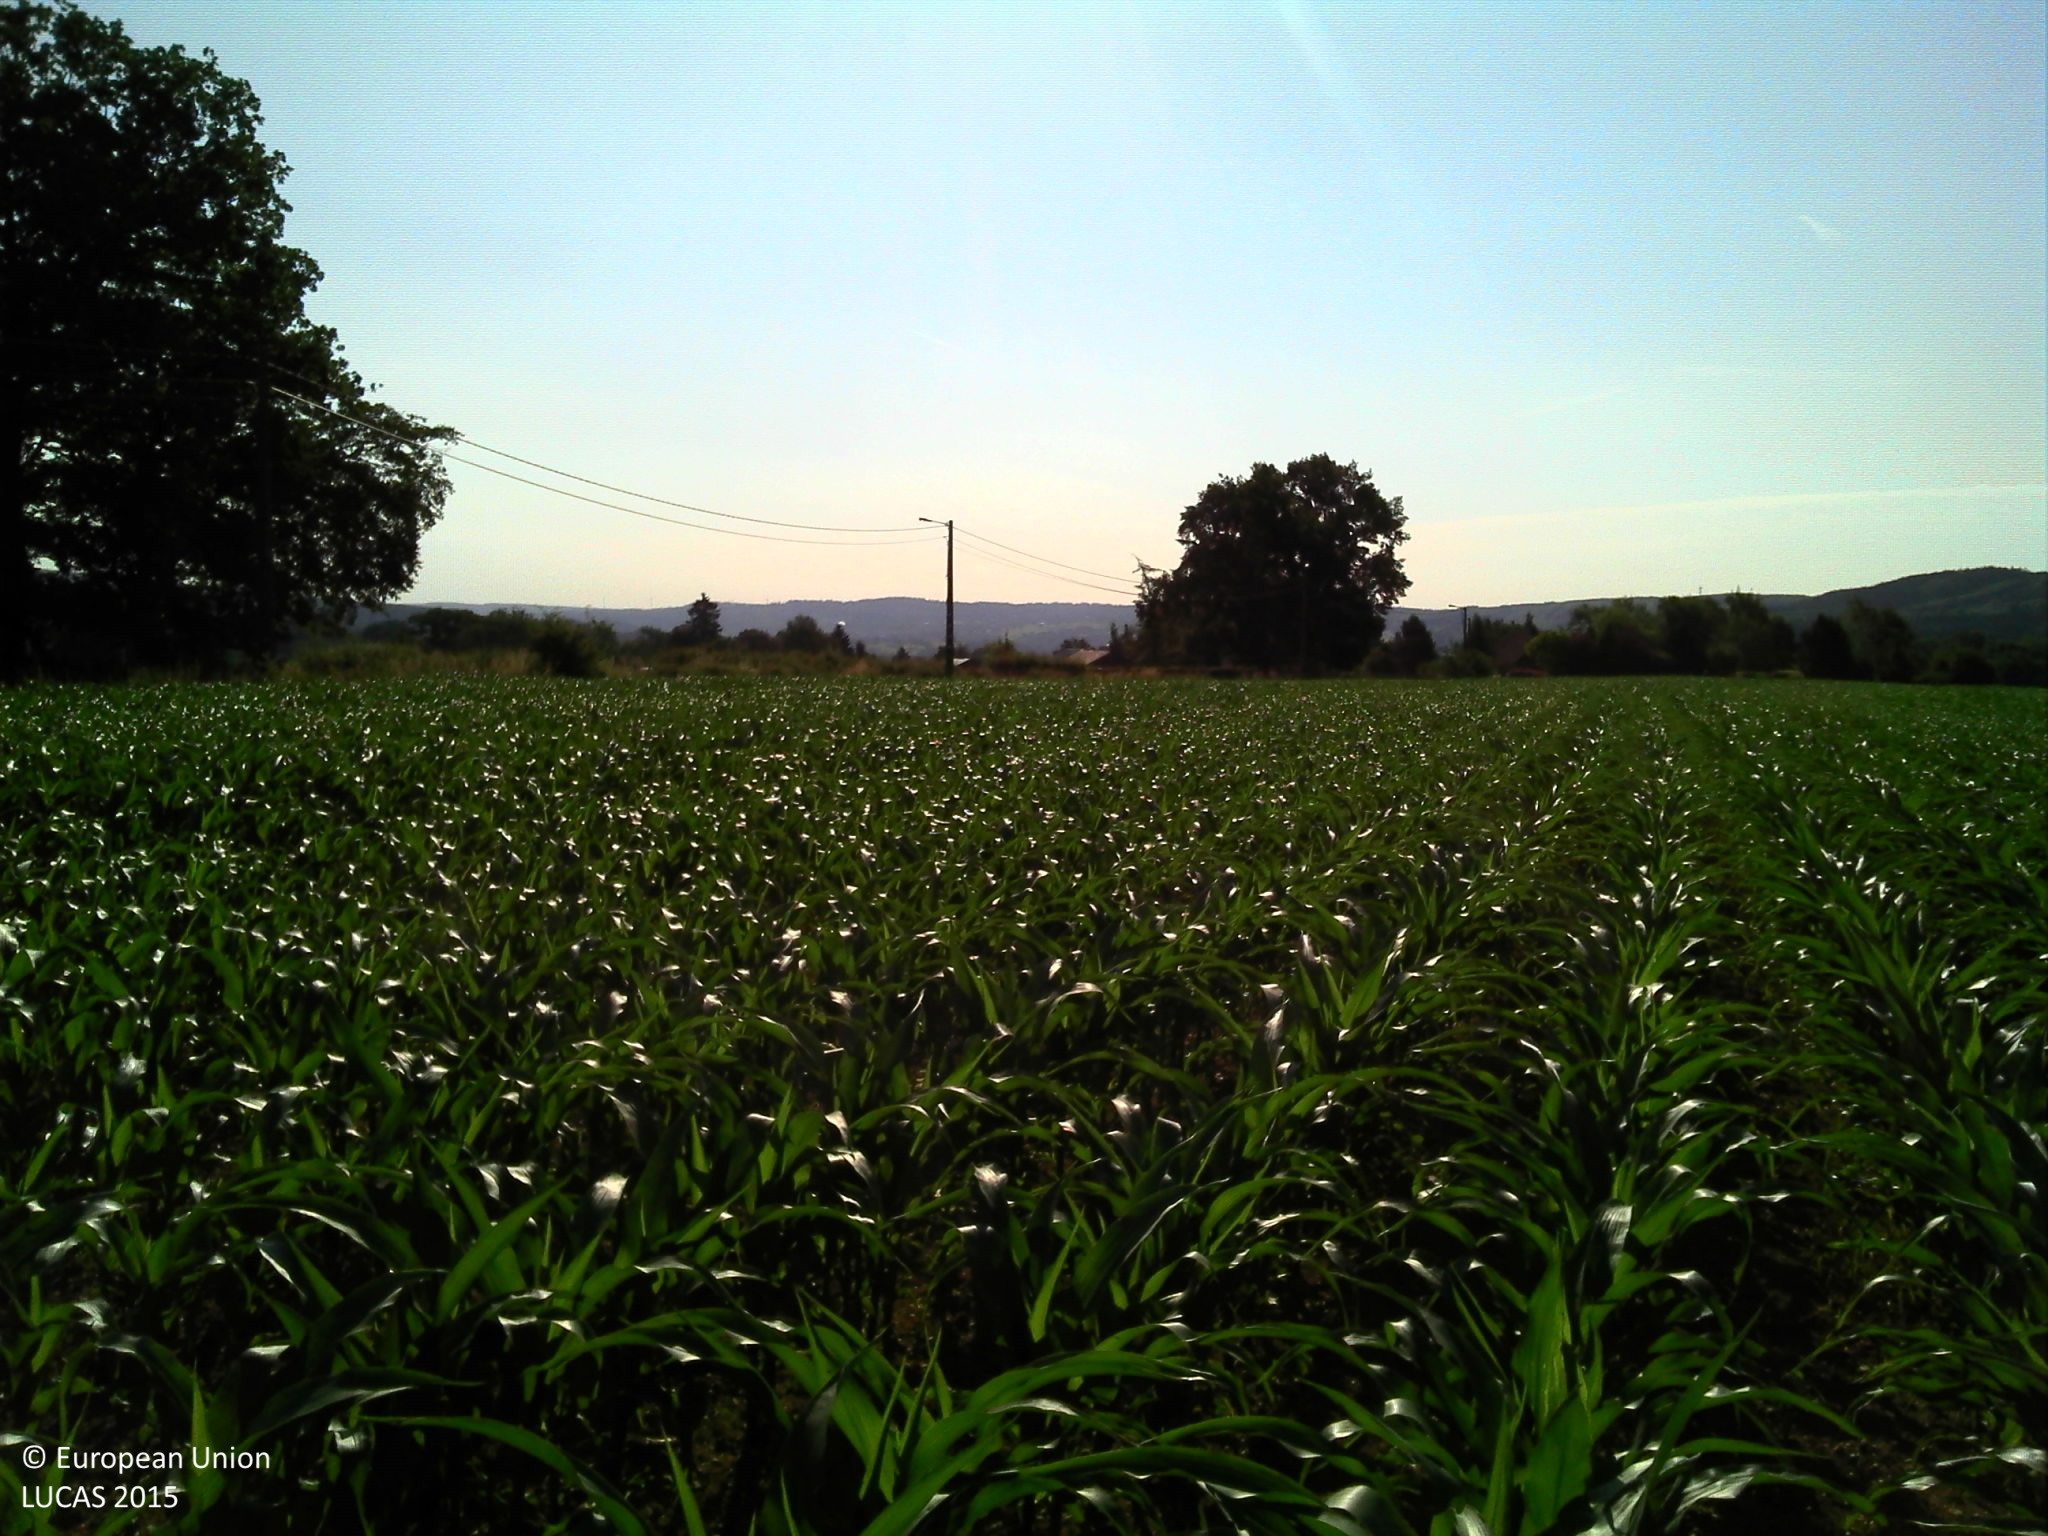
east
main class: Cropland
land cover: Maize
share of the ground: 50 - 75 %
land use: Agriculture (excluding fallow land and kitchen gardens)
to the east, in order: Maize; Fences; Electric lines; Grass margins; Paved roads, cycling and walking lanes; Grass margins; Managed hedges; Fences; Grassland without tree/shrub cover; Artificial constructions in urban areas; Grassland without tree/shrub cover
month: July
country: BE
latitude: 50.2891
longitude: 5.8583
